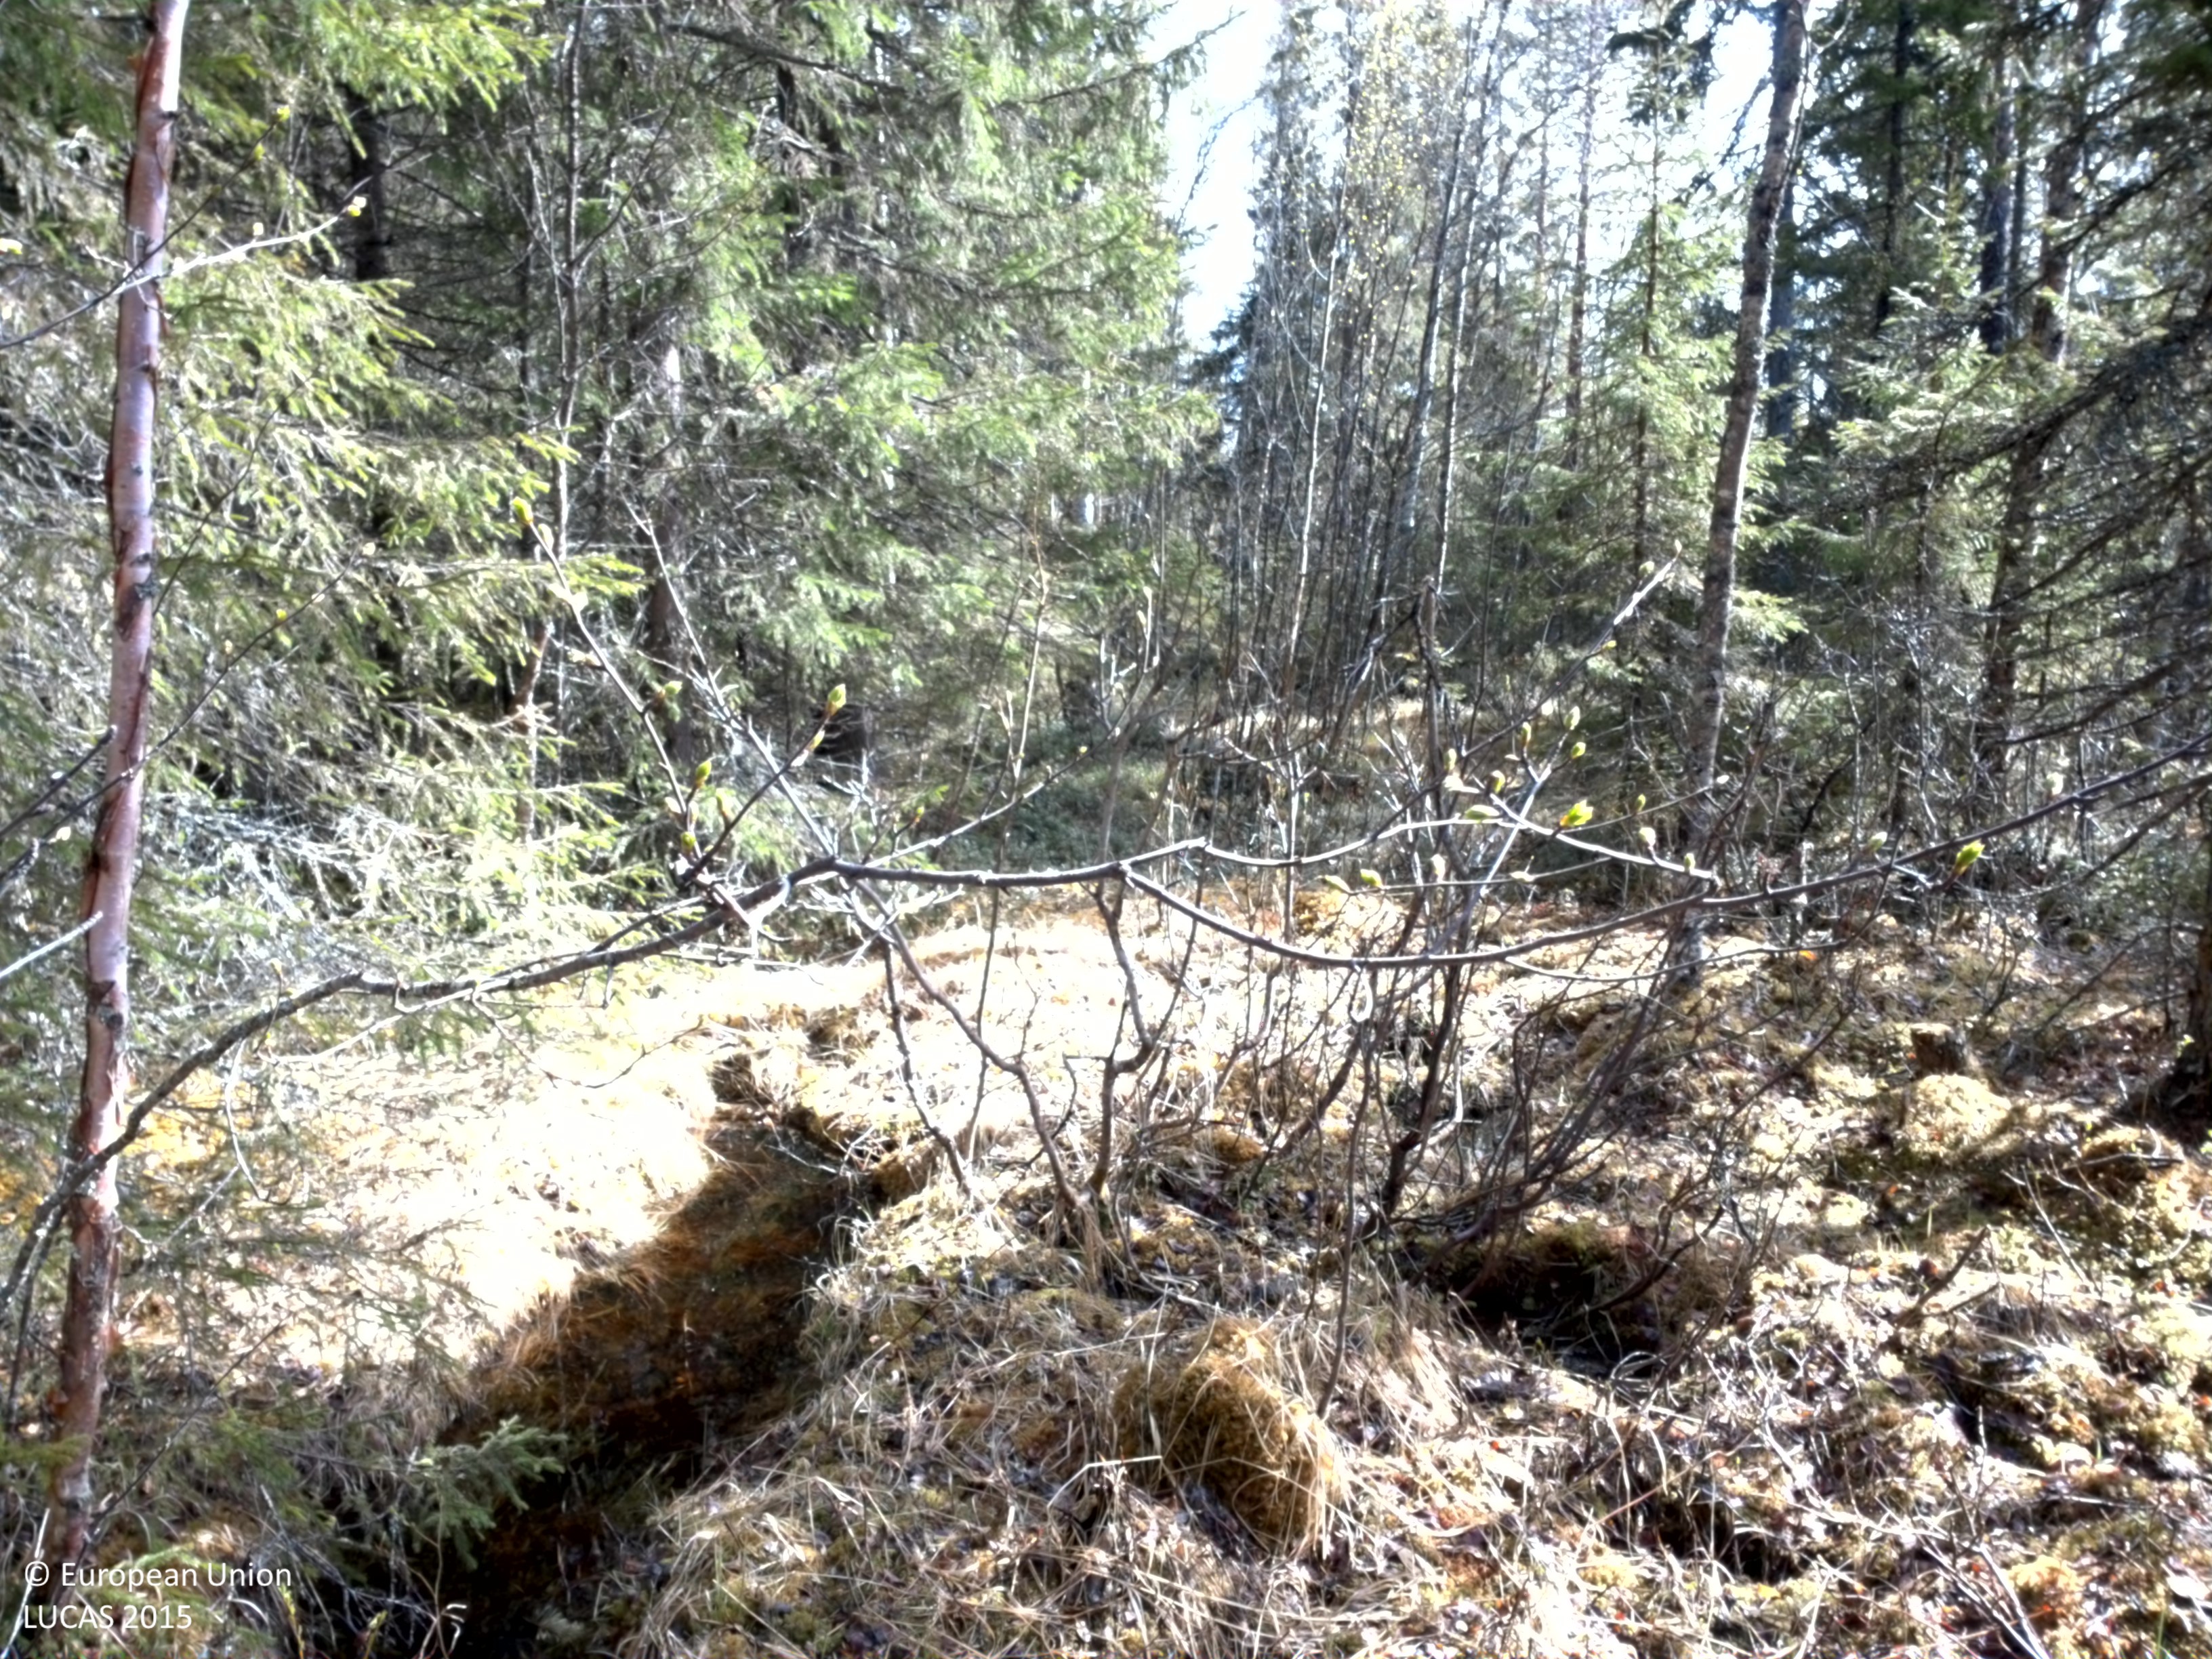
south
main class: Woodland
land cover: Spruce dominated mixed woodland
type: boreal forest
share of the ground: > 75 %
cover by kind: coniferous forest trees 65 %, broadleaved forest trees 25 %, shrubs 10 %
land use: Forestry
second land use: Amenities, museums, leisure
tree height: > 5 m
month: June
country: SE
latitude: 63.6071
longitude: 14.6347
